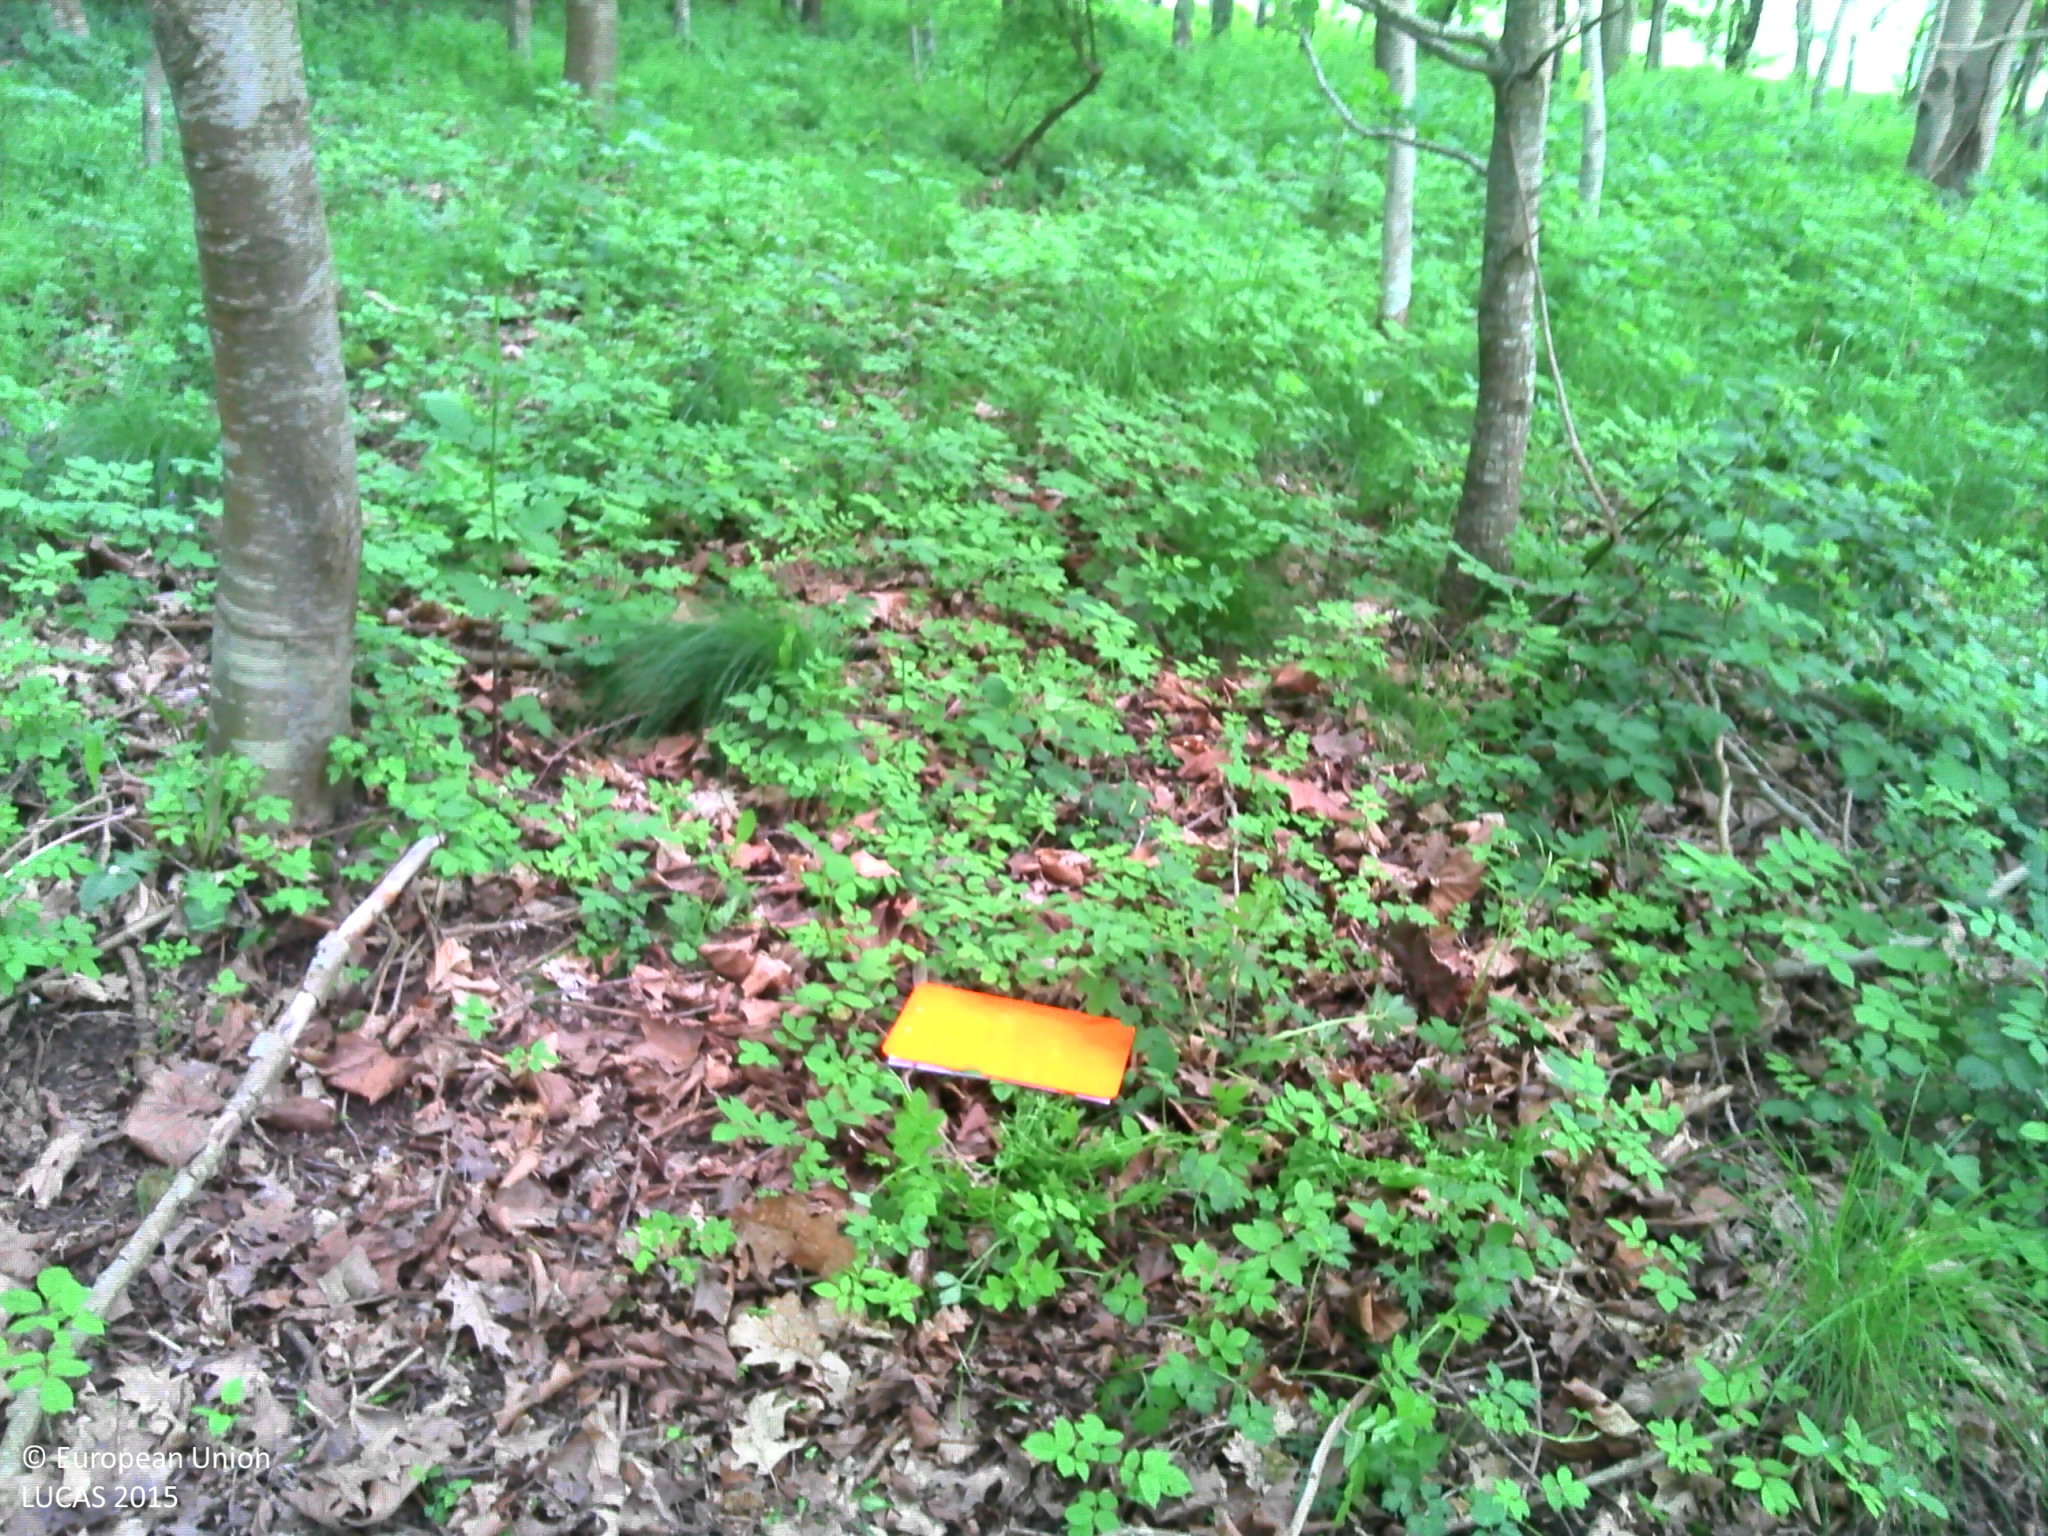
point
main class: Woodland
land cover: Broadleaved woodland
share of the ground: > 75 %
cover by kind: broadleaved forest trees 85 %, shrubs 10 %, herbaceous plants 5 %
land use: Forestry
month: May
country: FR
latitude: 49.3107
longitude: 0.0242
